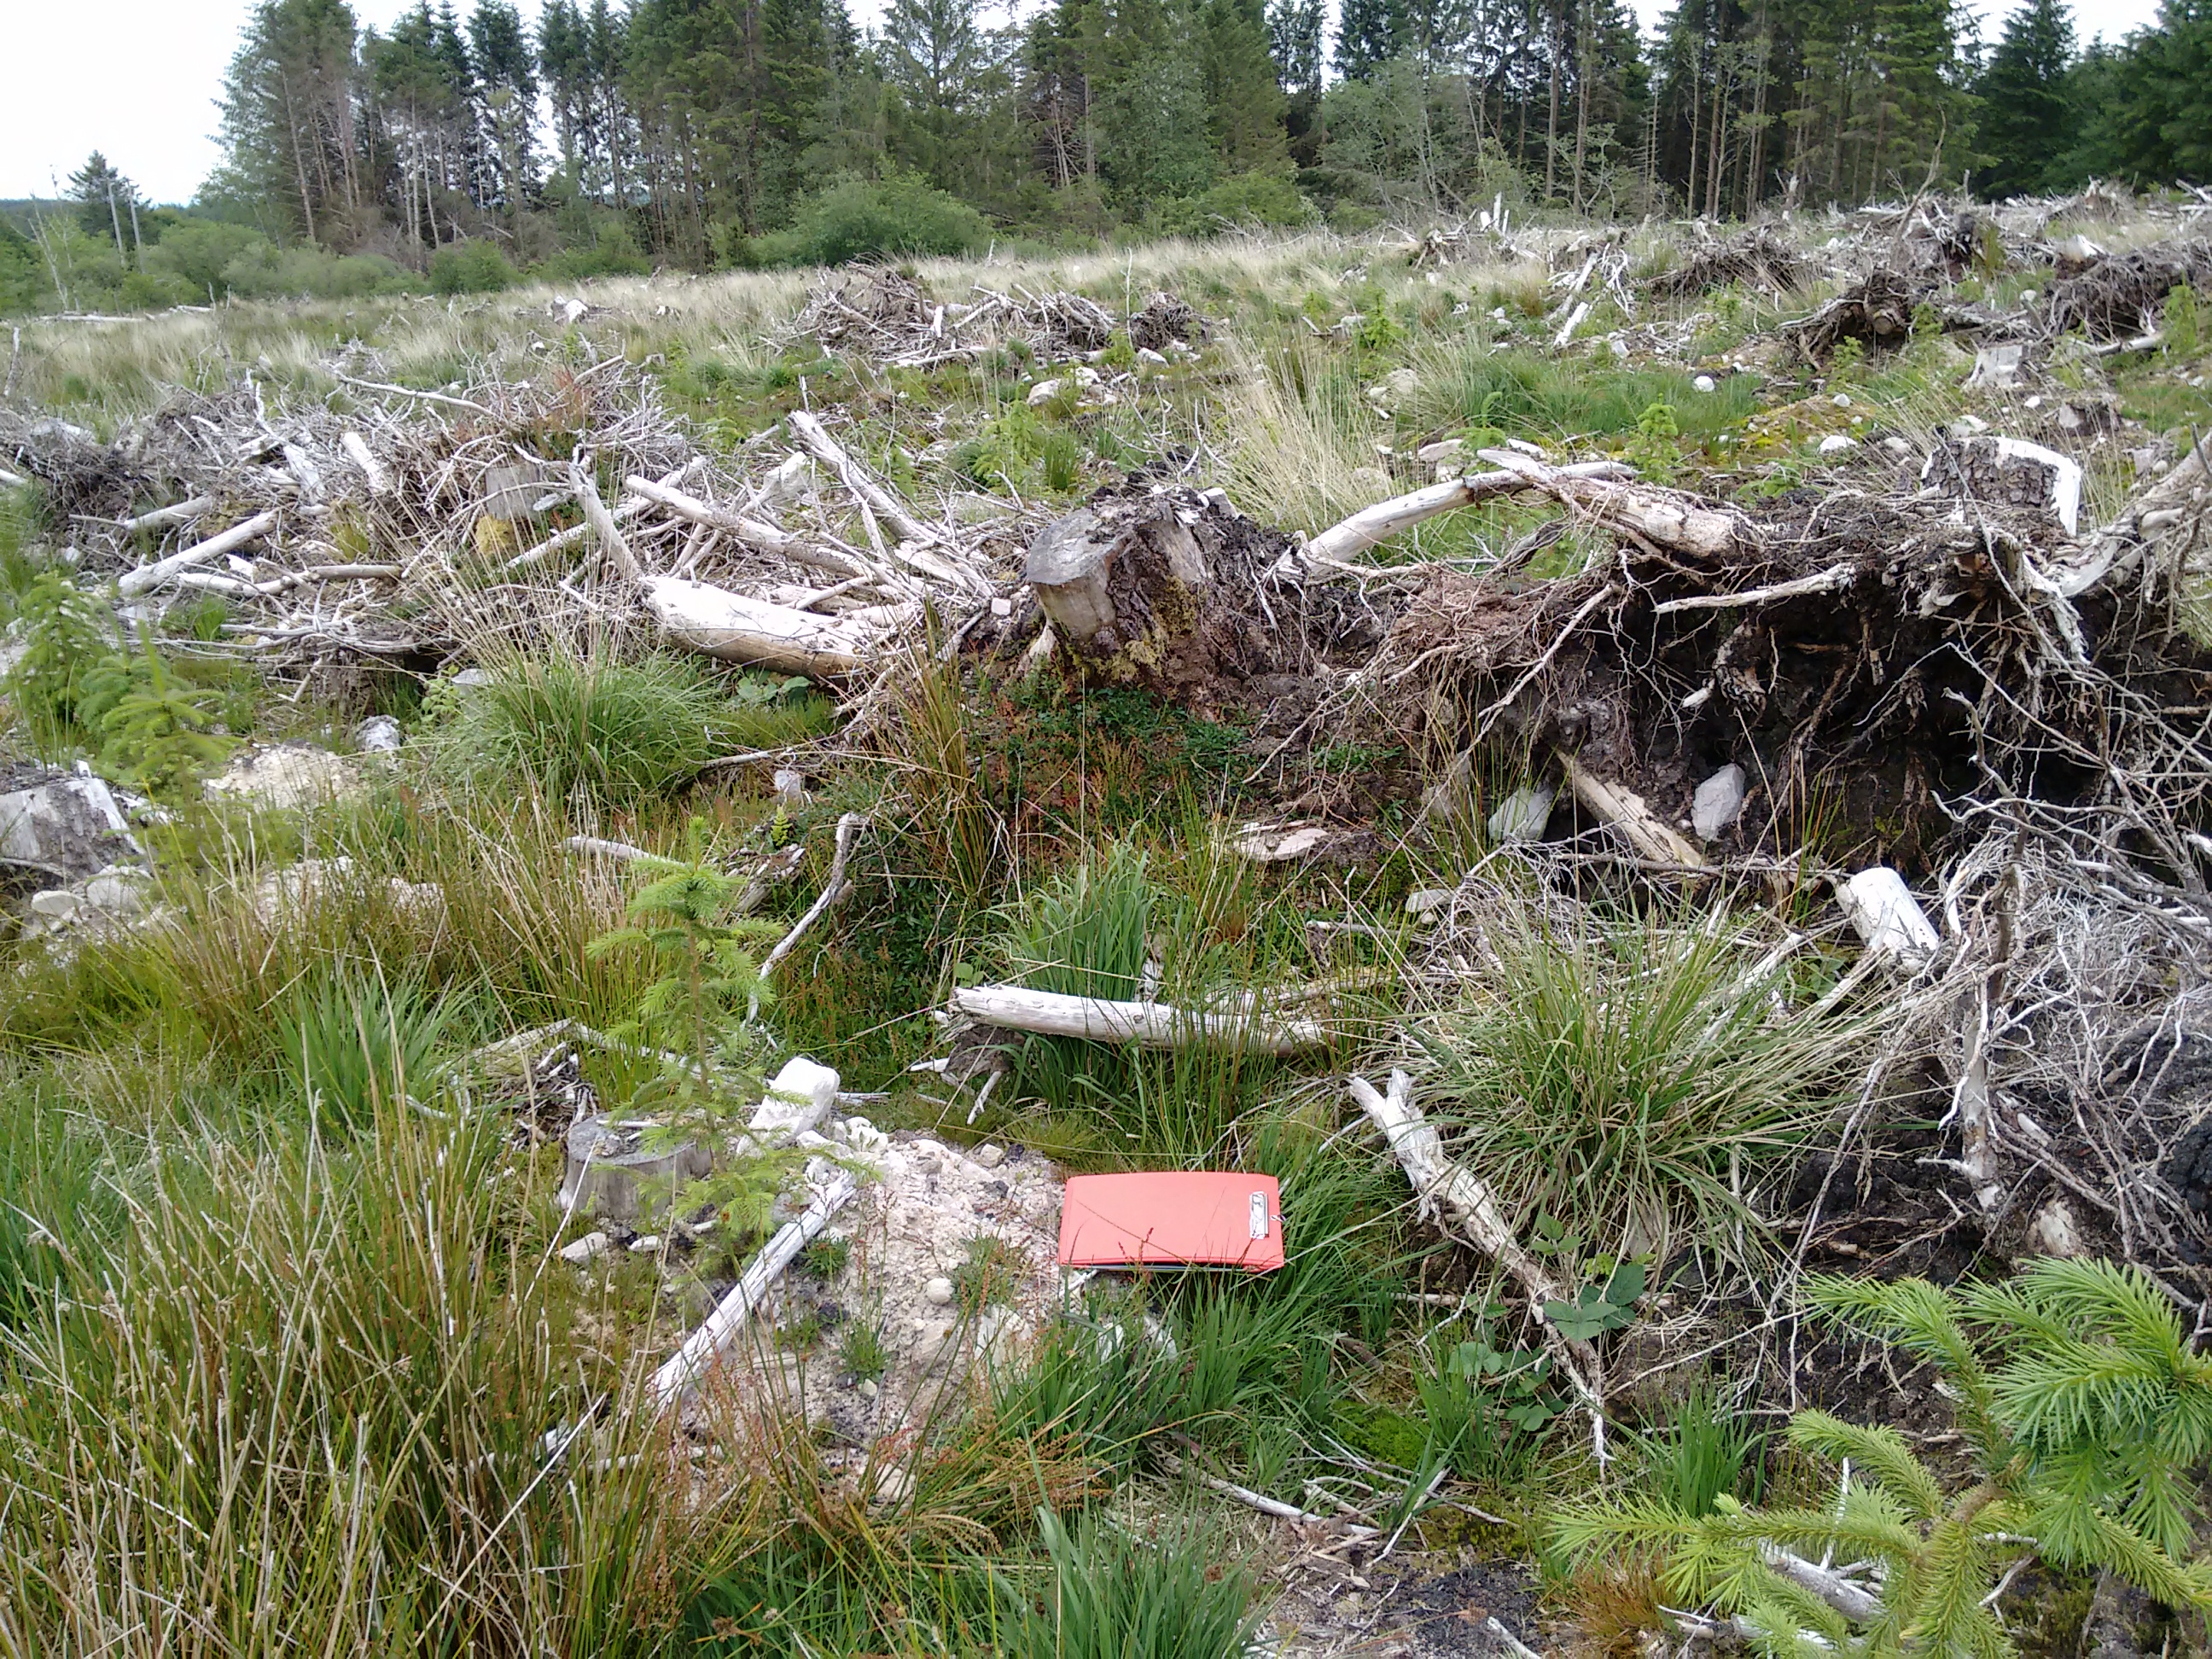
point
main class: Grassland
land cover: Grassland with sparse tree/shrub cover
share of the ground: > 75 %
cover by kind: herbaceous plants 35 %, lichens and mosses 10 %, broadleaved forest trees 5 %, shrubs 5 %
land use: Forestry
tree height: < 5 m
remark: Clear cut
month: June
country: IE
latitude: 53.0483
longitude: -8.4971
